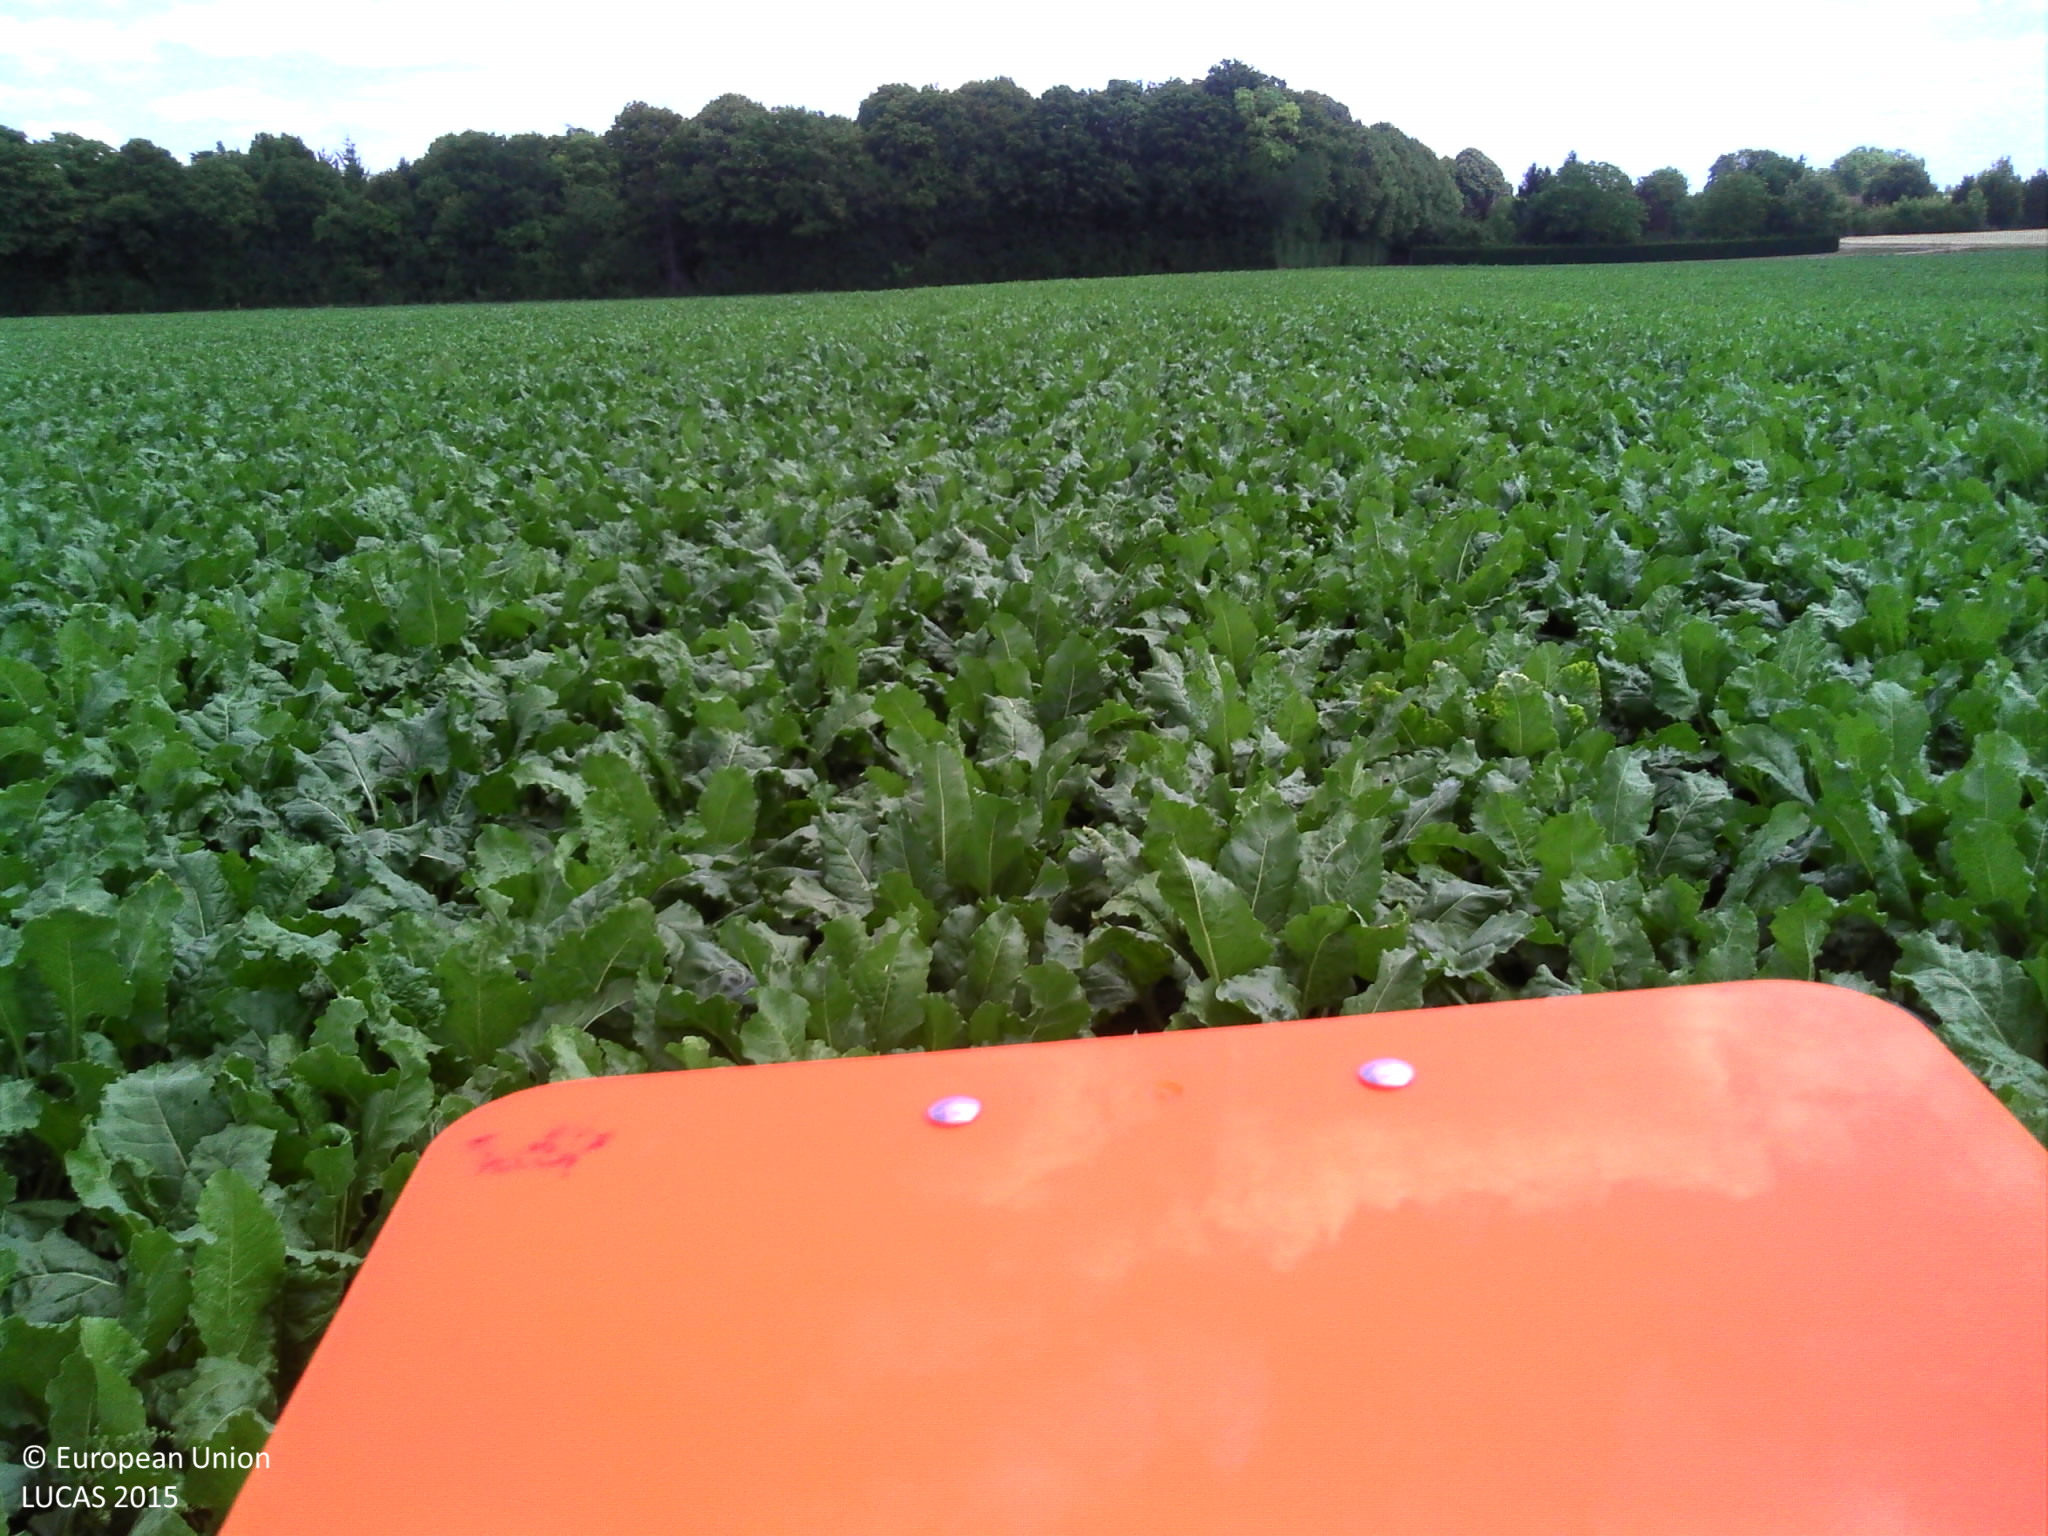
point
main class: Cropland
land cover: Sugar beet
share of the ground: > 75 %
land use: Agriculture (excluding fallow land and kitchen gardens)
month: July
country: FR
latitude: 48.0575
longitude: 2.4900
